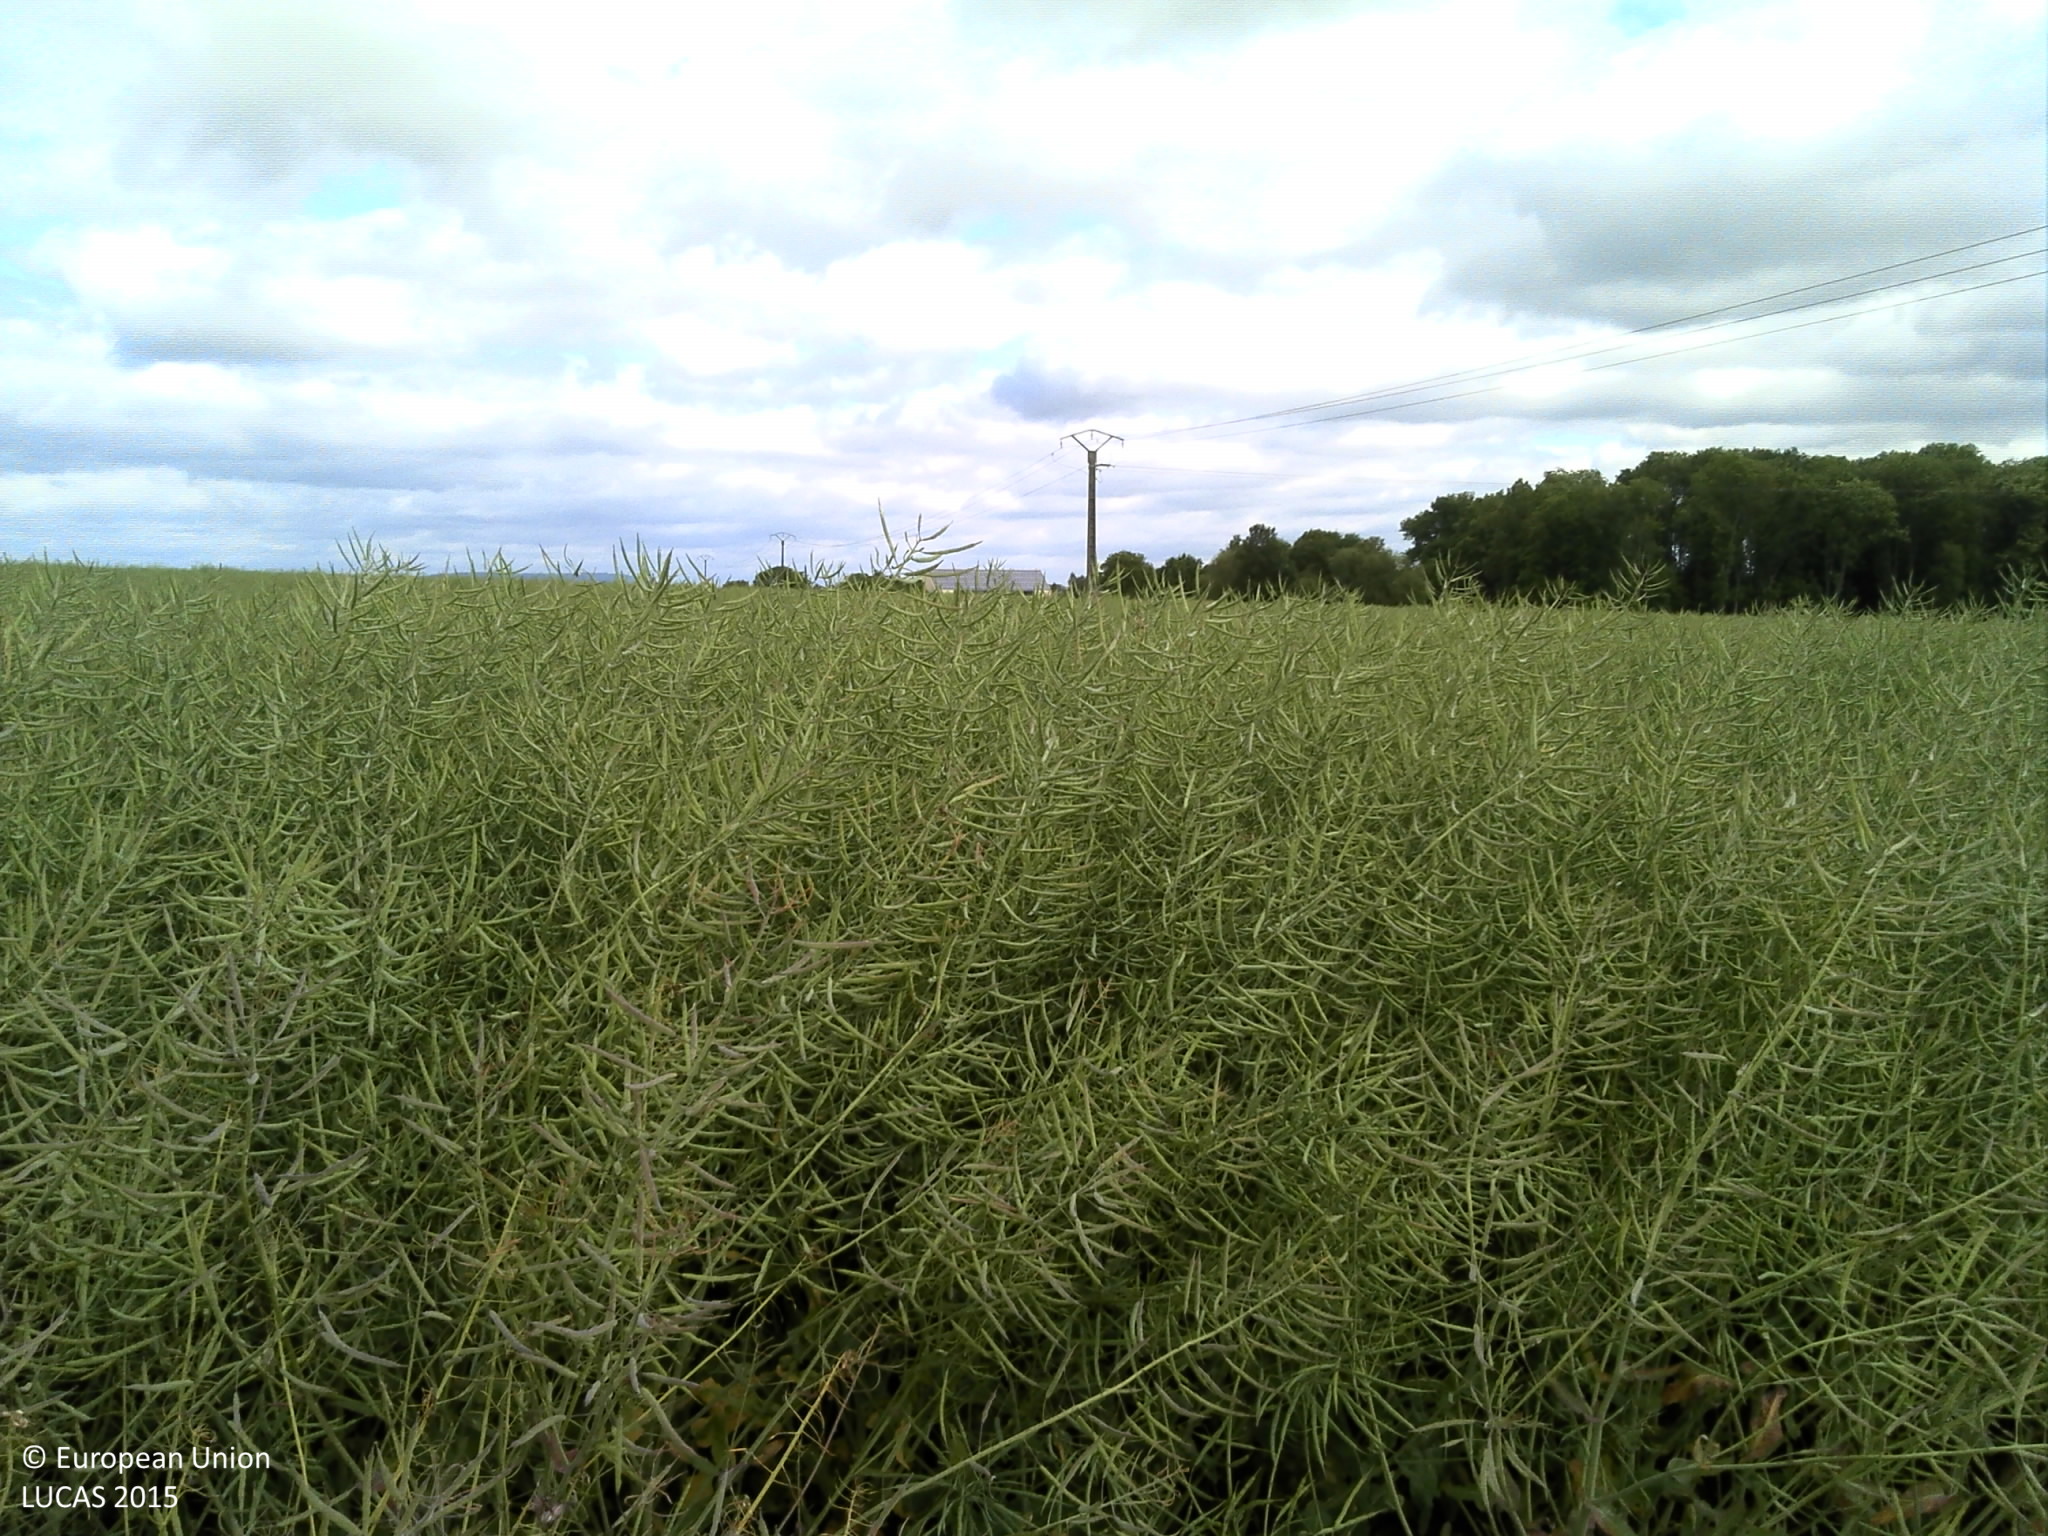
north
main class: Cropland
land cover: Rape and turnip rape
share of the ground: > 75 %
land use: Agriculture (excluding fallow land and kitchen gardens)
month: June
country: FR
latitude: 49.0032
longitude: 6.1586
